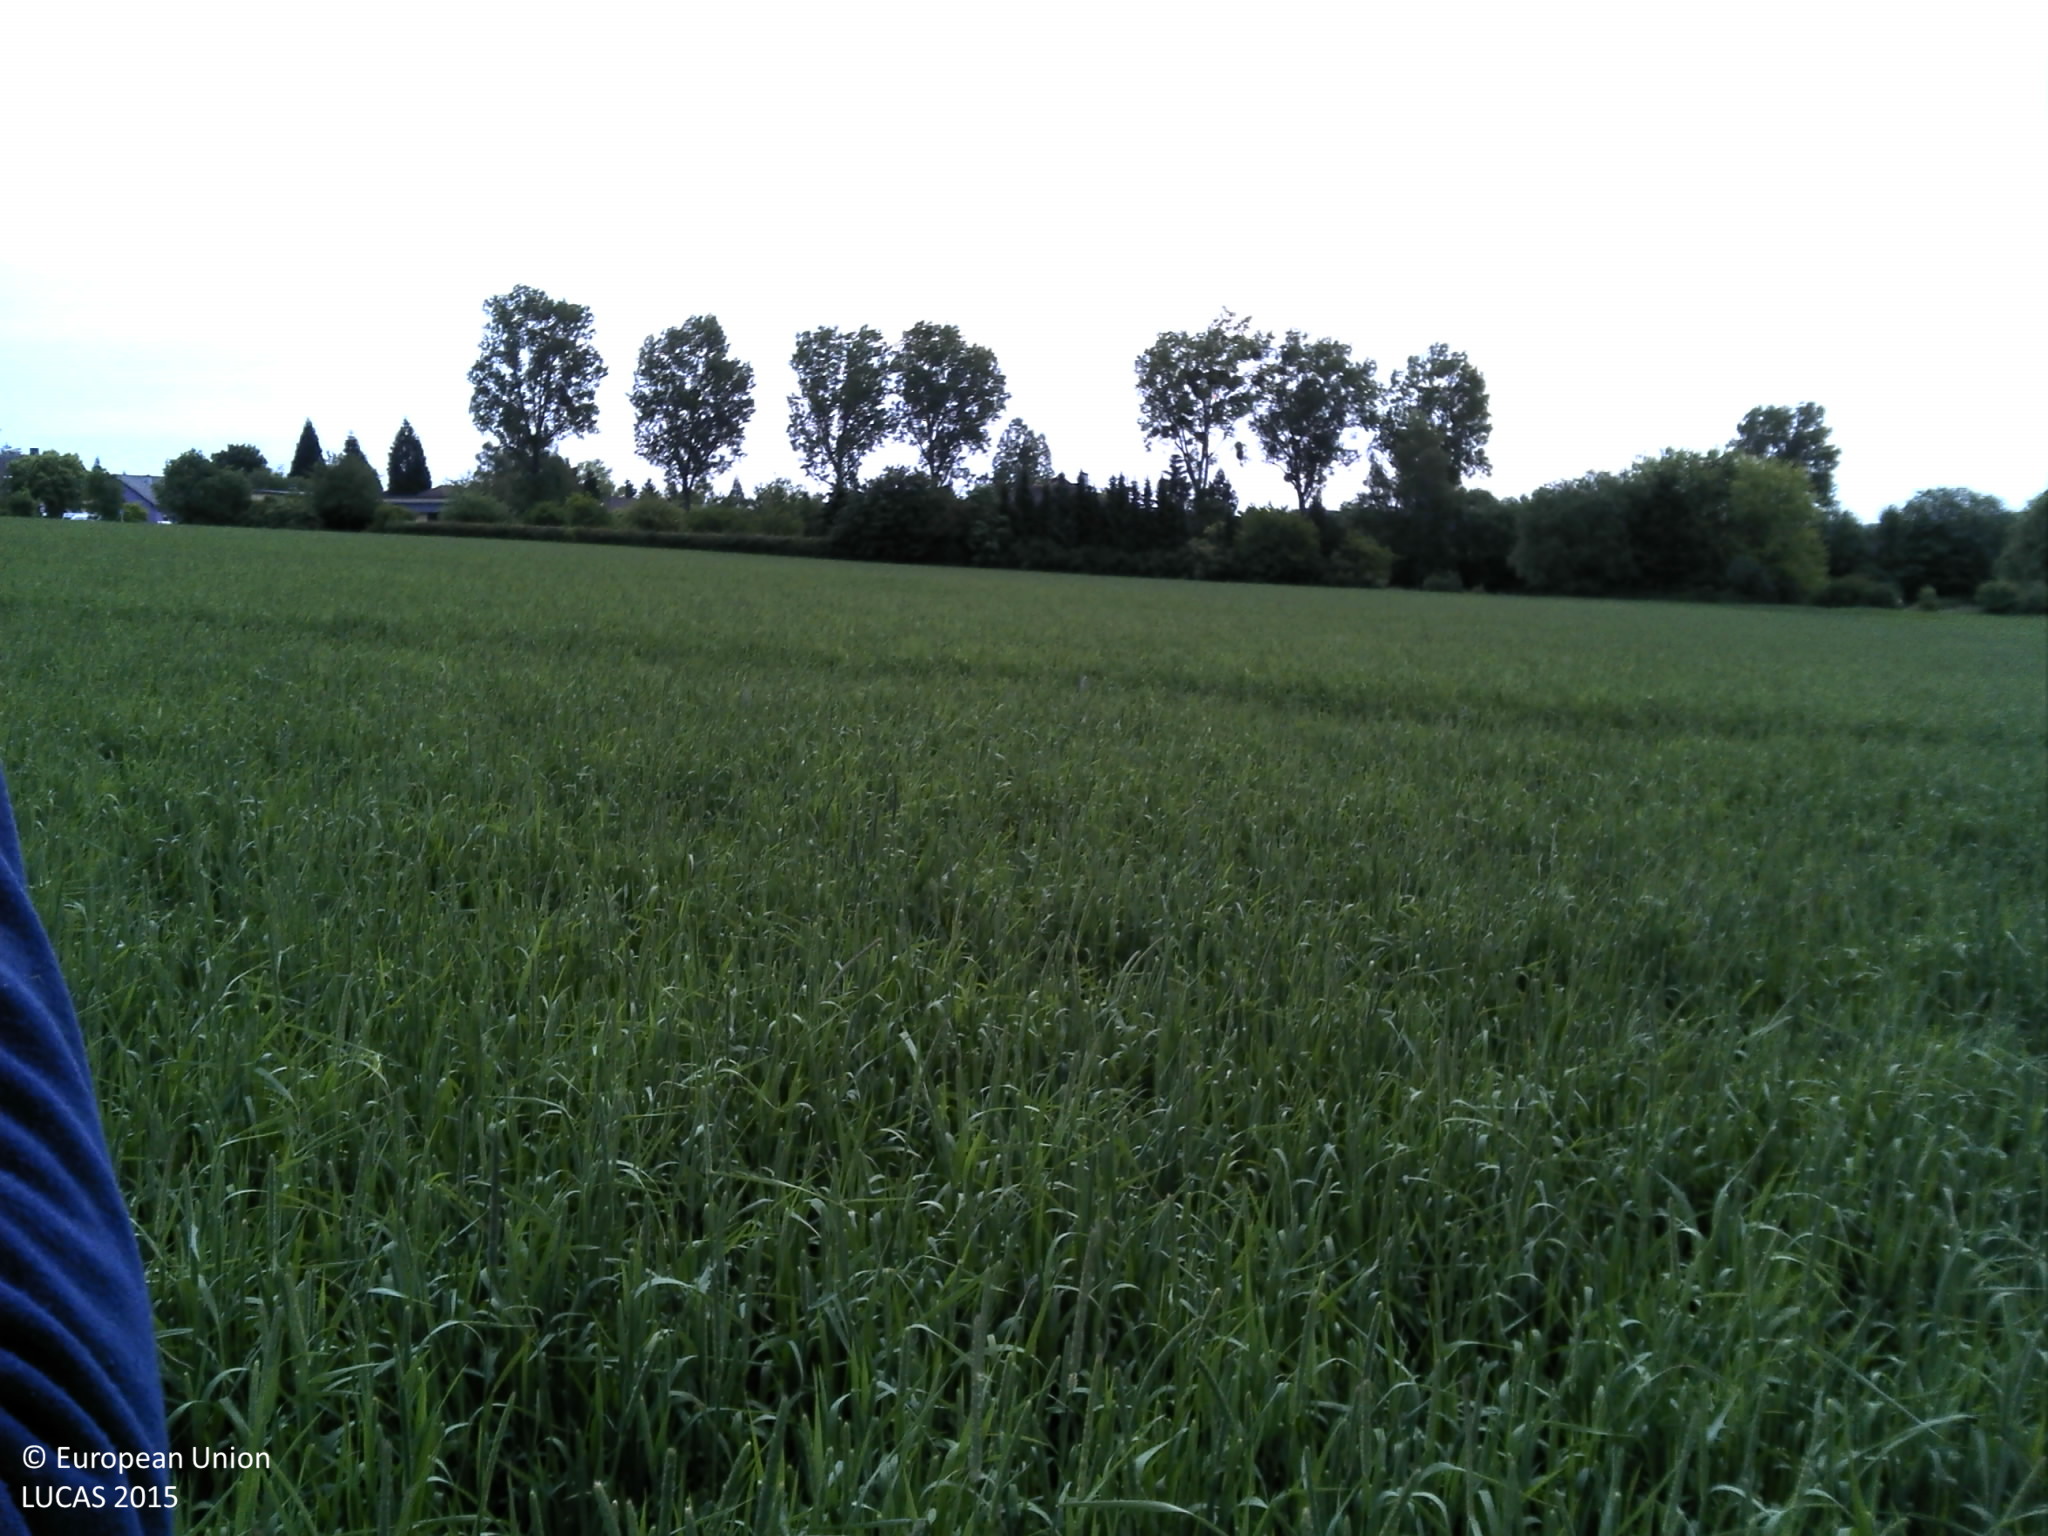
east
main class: Cropland
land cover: Temporary grasslands
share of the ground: > 75 %
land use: Agriculture (excluding fallow land and kitchen gardens)
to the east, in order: Temporary grasslands; Artificial constructions in urban areas; Ditches and canals; Grass margins; Paved roads, cycling and walking lanes; Grass margins; Ditches and canals; Fences; Grassland without tree/shrub cover
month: June
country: LU
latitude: 49.5551
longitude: 5.9766
